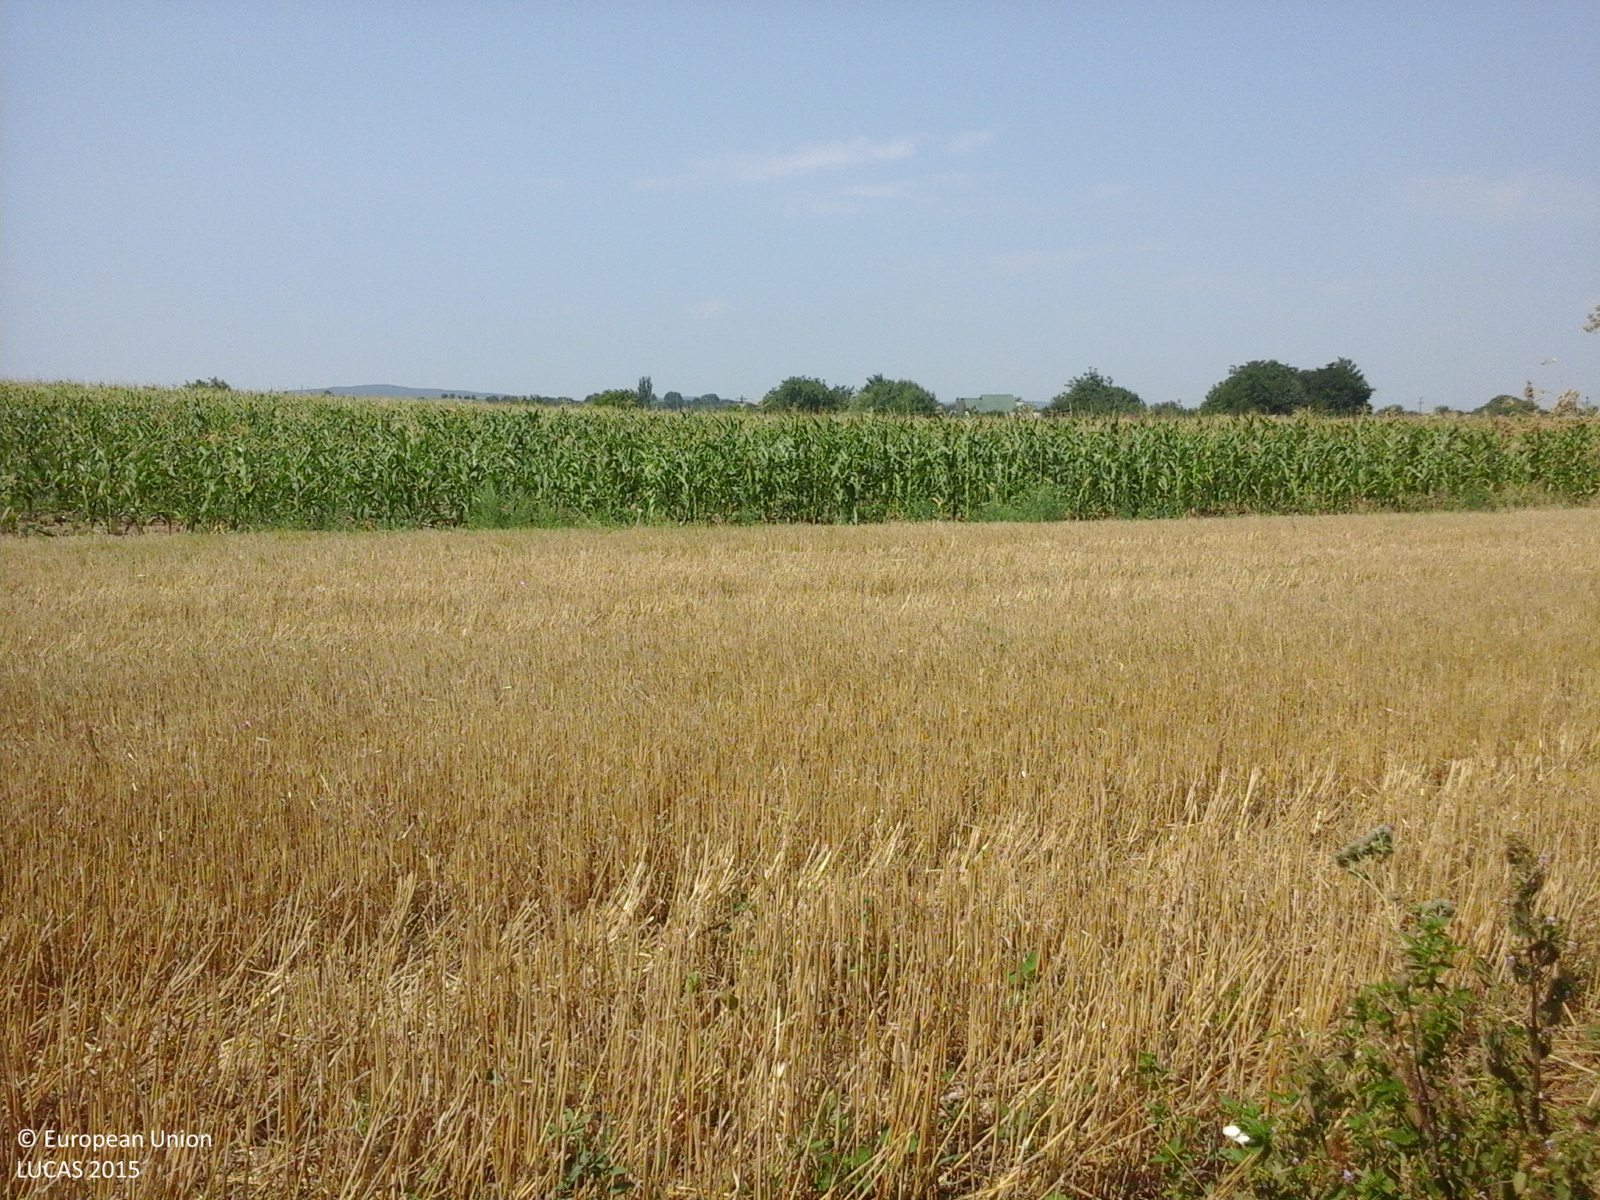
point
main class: Cropland
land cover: Maize
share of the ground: > 75 %
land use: Agriculture (excluding fallow land and kitchen gardens)
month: August
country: RO
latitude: 46.1919
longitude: 27.1096
